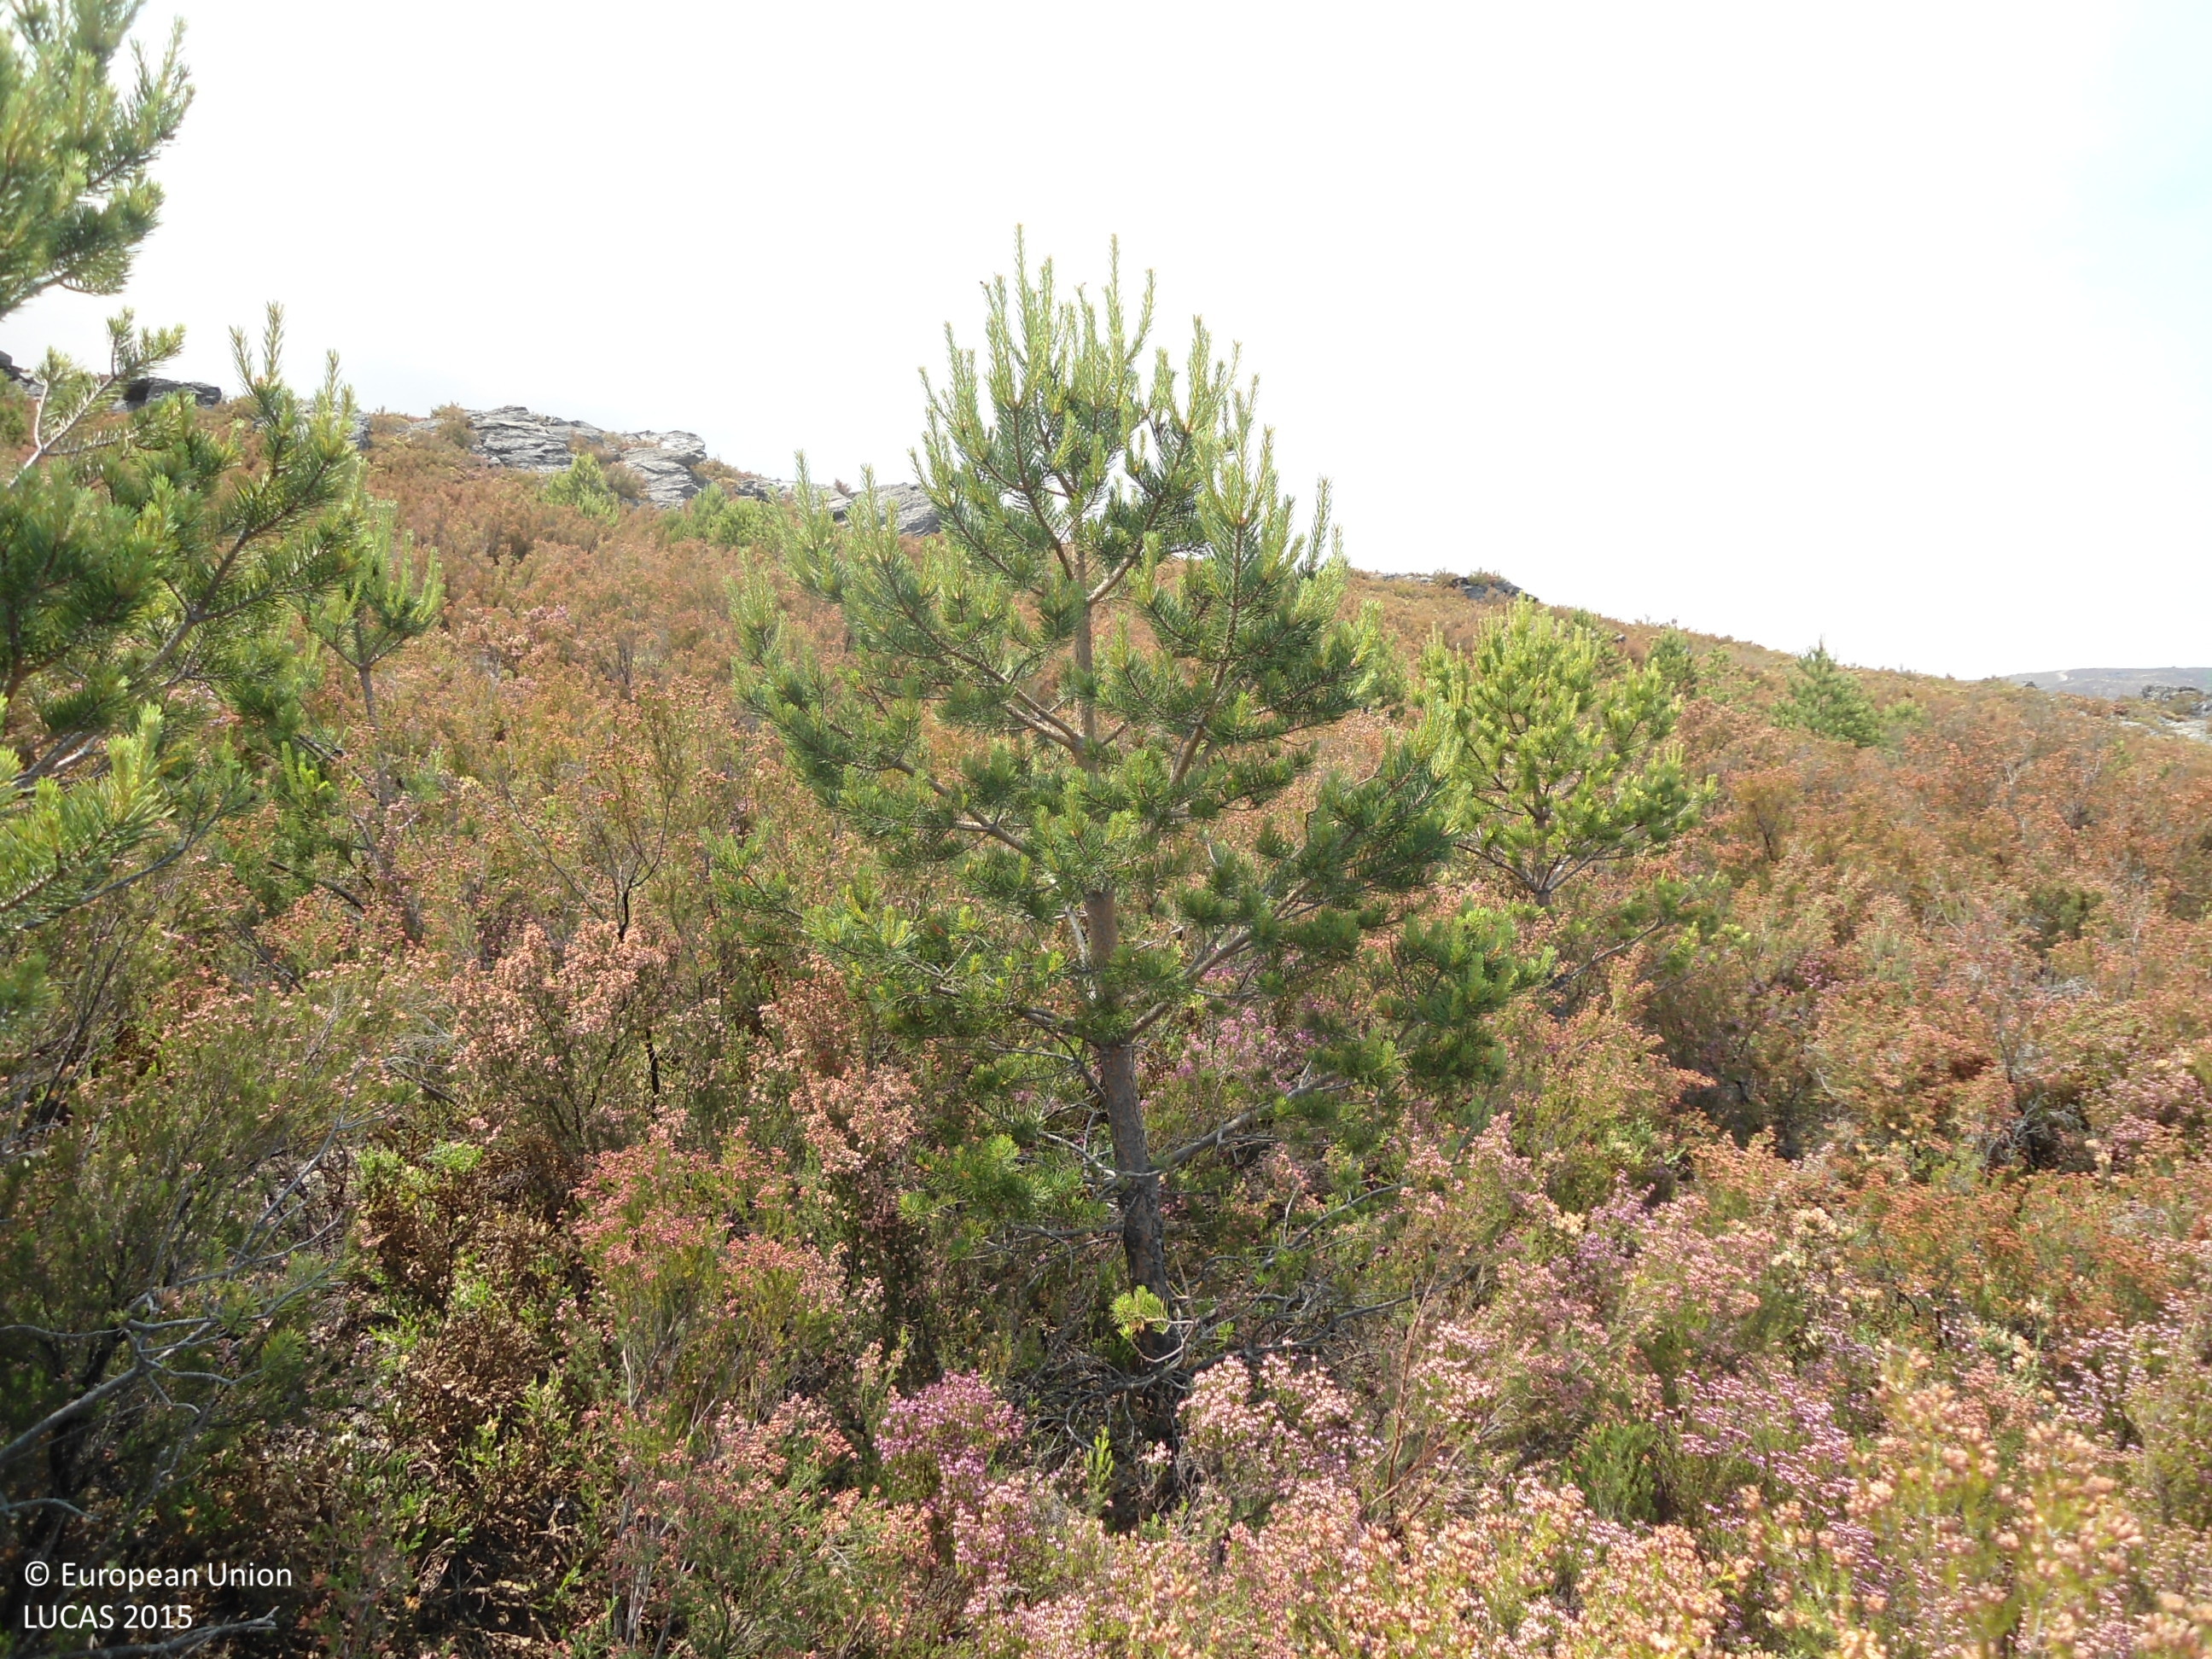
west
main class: Woodland
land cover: Pine dominated coniferous woodland
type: coniferous forest of the mediterranean region
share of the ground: 10 - 25 %
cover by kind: shrubs 90 %, coniferous forest trees 10 %
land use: Forestry
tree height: < 5 m
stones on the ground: > 50 %
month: June
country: ES
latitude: 42.0037
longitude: -6.7408
